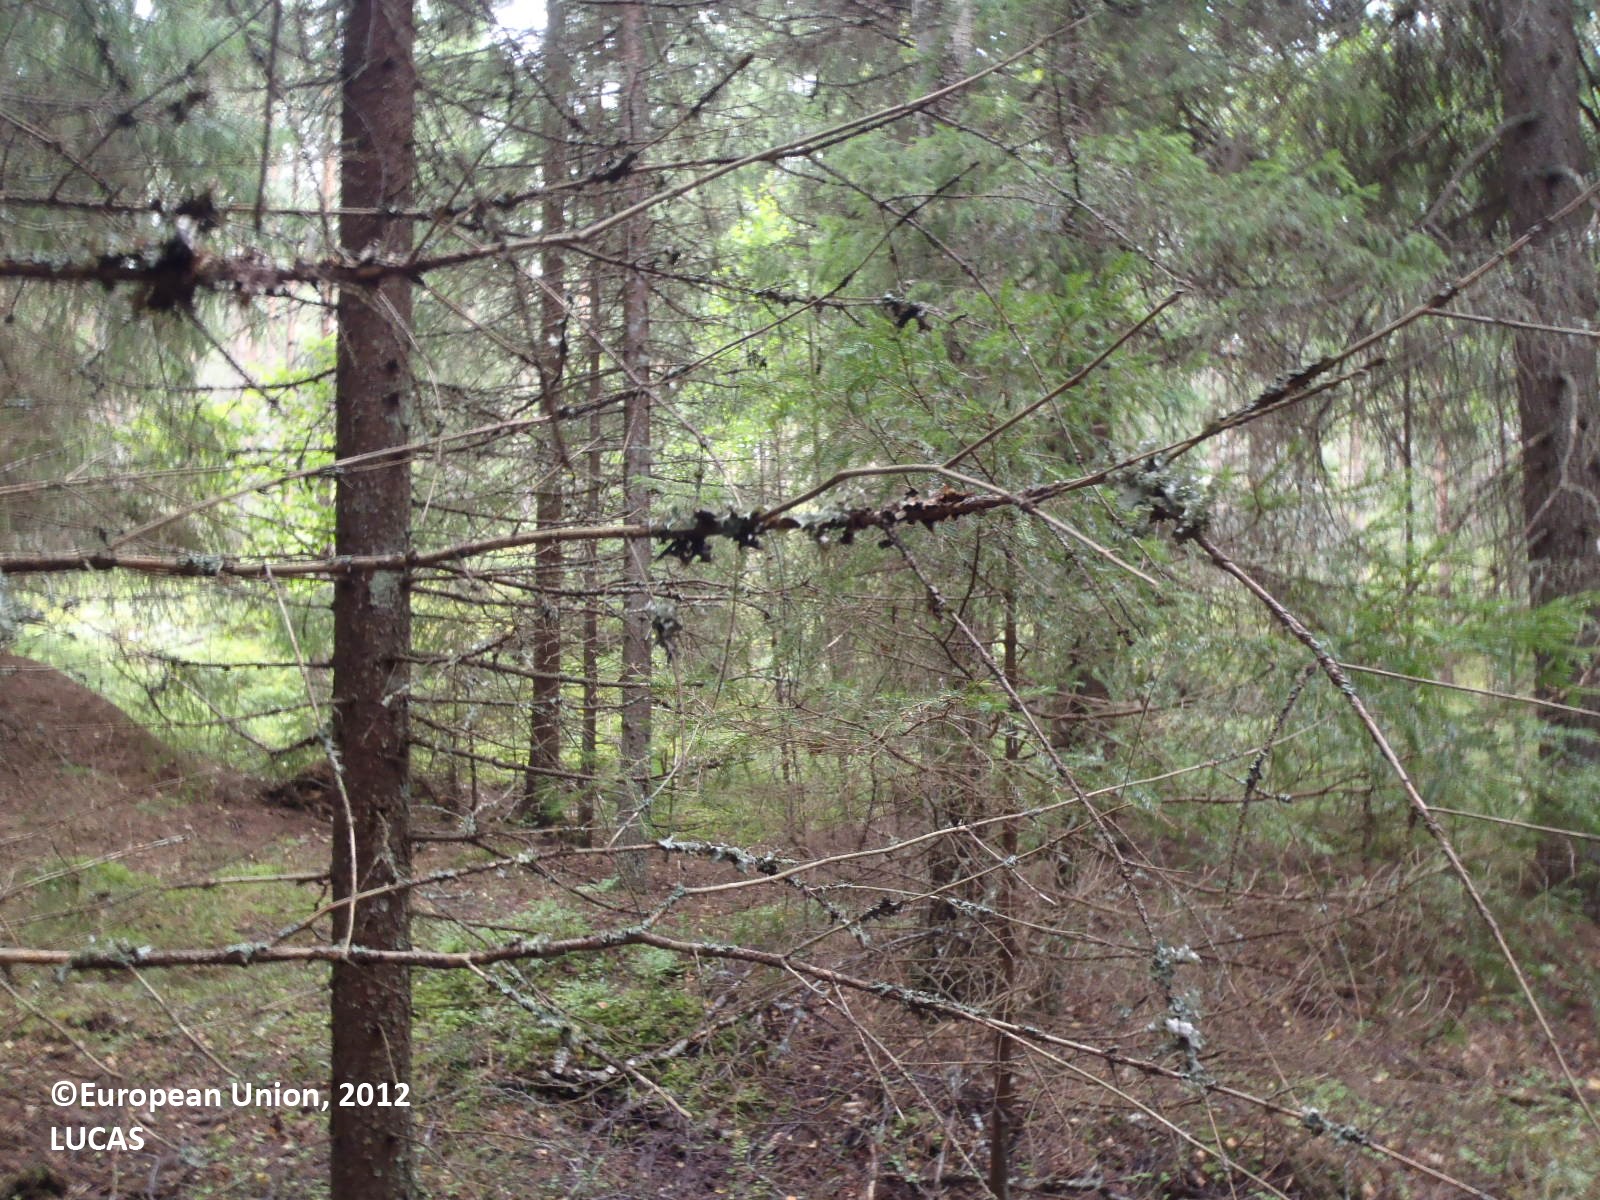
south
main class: Woodland
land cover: Spruce dominated coniferous woodland
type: boreal forest
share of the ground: > 75 %
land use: Forestry
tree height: > 5 m
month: August
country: FI
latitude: 60.7545
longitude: 21.8584
